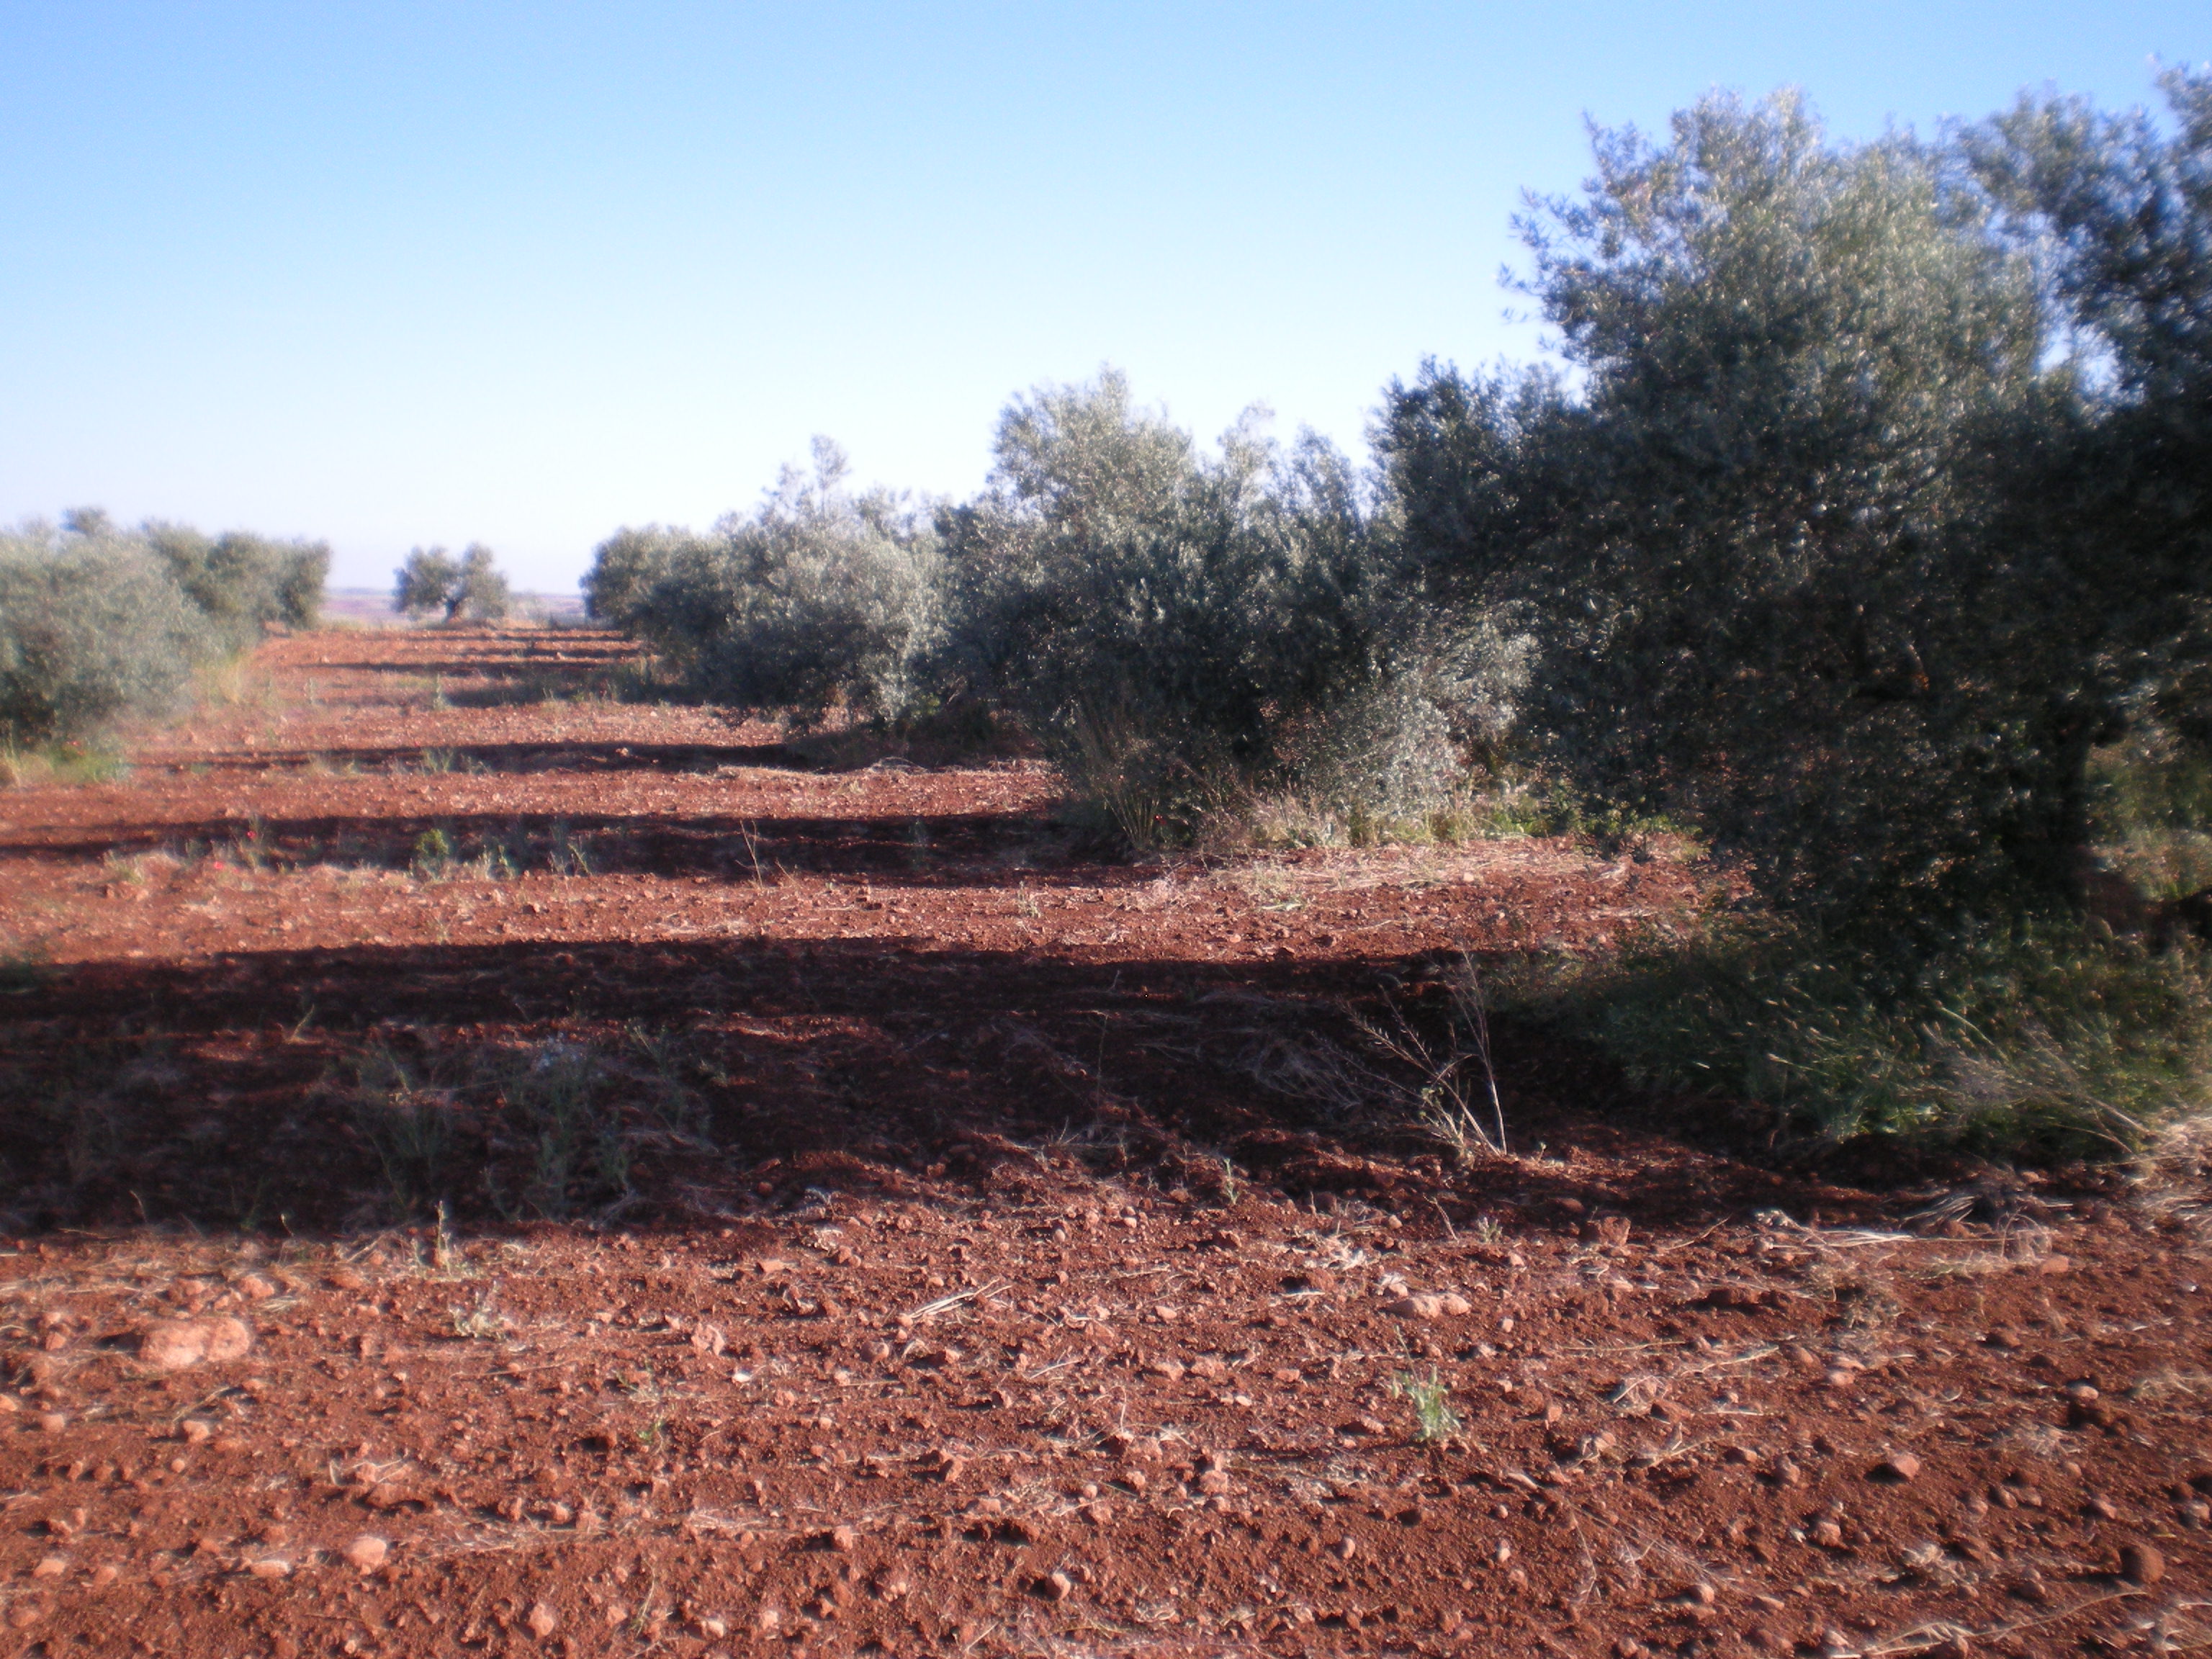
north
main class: Cropland
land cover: Olive groves
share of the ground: 10 - 25 %
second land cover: Other bare soil
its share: > 75 %
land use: Agriculture (excluding fallow land and kitchen gardens)
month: May
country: ES
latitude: 38.6746
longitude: -2.9362
